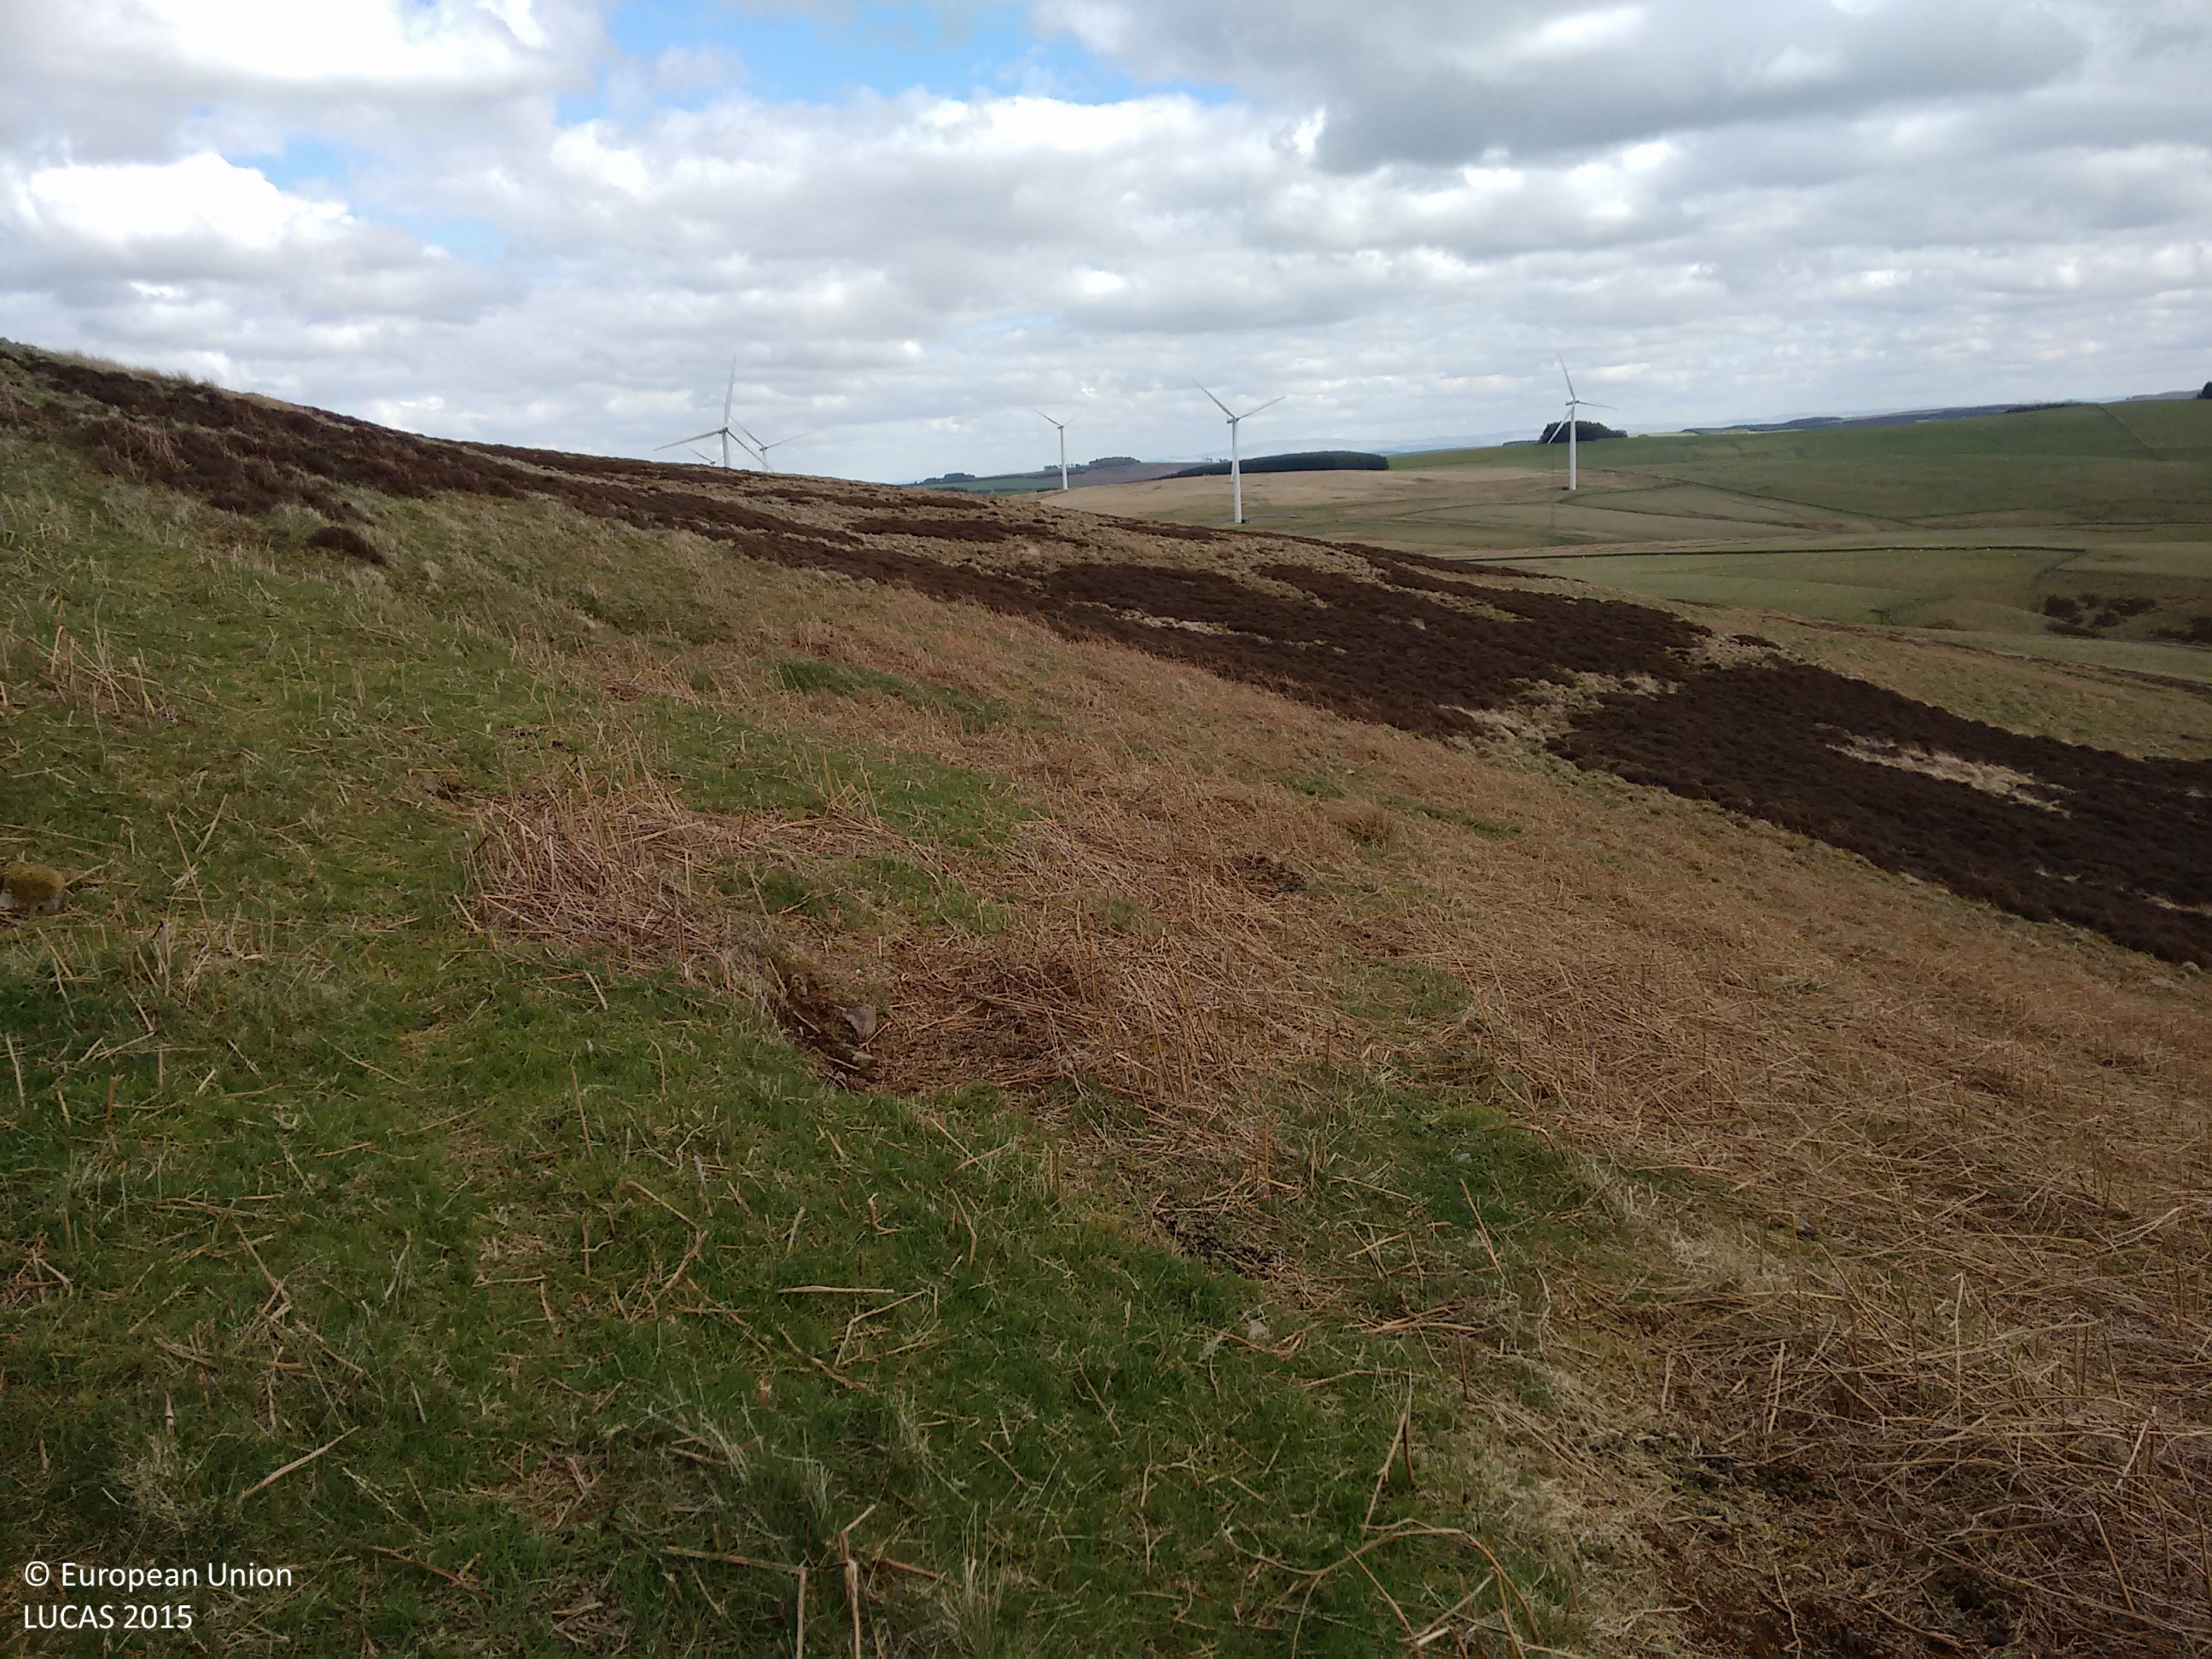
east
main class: Grassland
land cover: Grassland without tree/shrub cover
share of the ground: > 75 %
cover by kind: herbaceous plants 95 %, shrubs 5 %
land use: Agriculture (excluding fallow land and kitchen gardens)
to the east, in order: Grassland without tree/shrub cover; Grassland with sparse tree/shrub cover
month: May
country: GB
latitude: 55.7703
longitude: -2.8987
